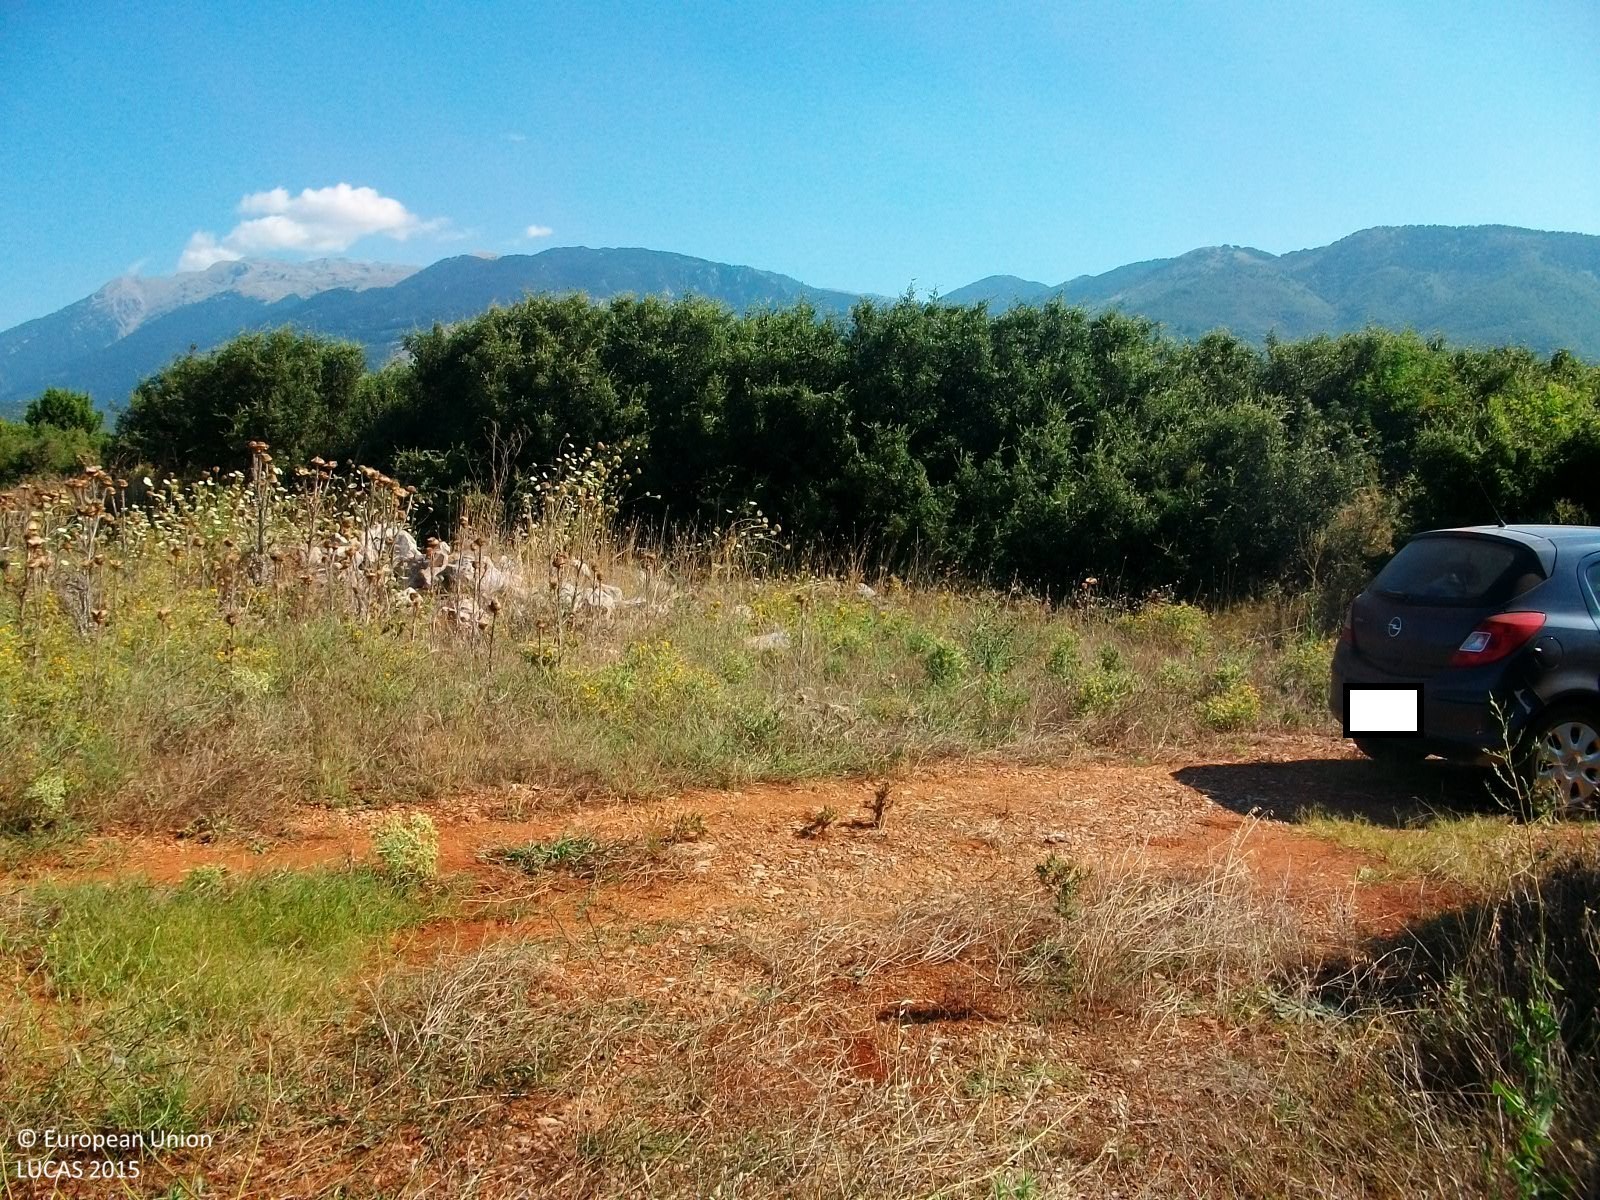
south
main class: Shrubland
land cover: Shrubland without tree cover
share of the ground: > 75 %
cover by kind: shrubs 90 %, herbaceous plants 10 %
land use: Semi-natural and natural areas not in use
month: July
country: GR
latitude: 38.6664
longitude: 22.5867
